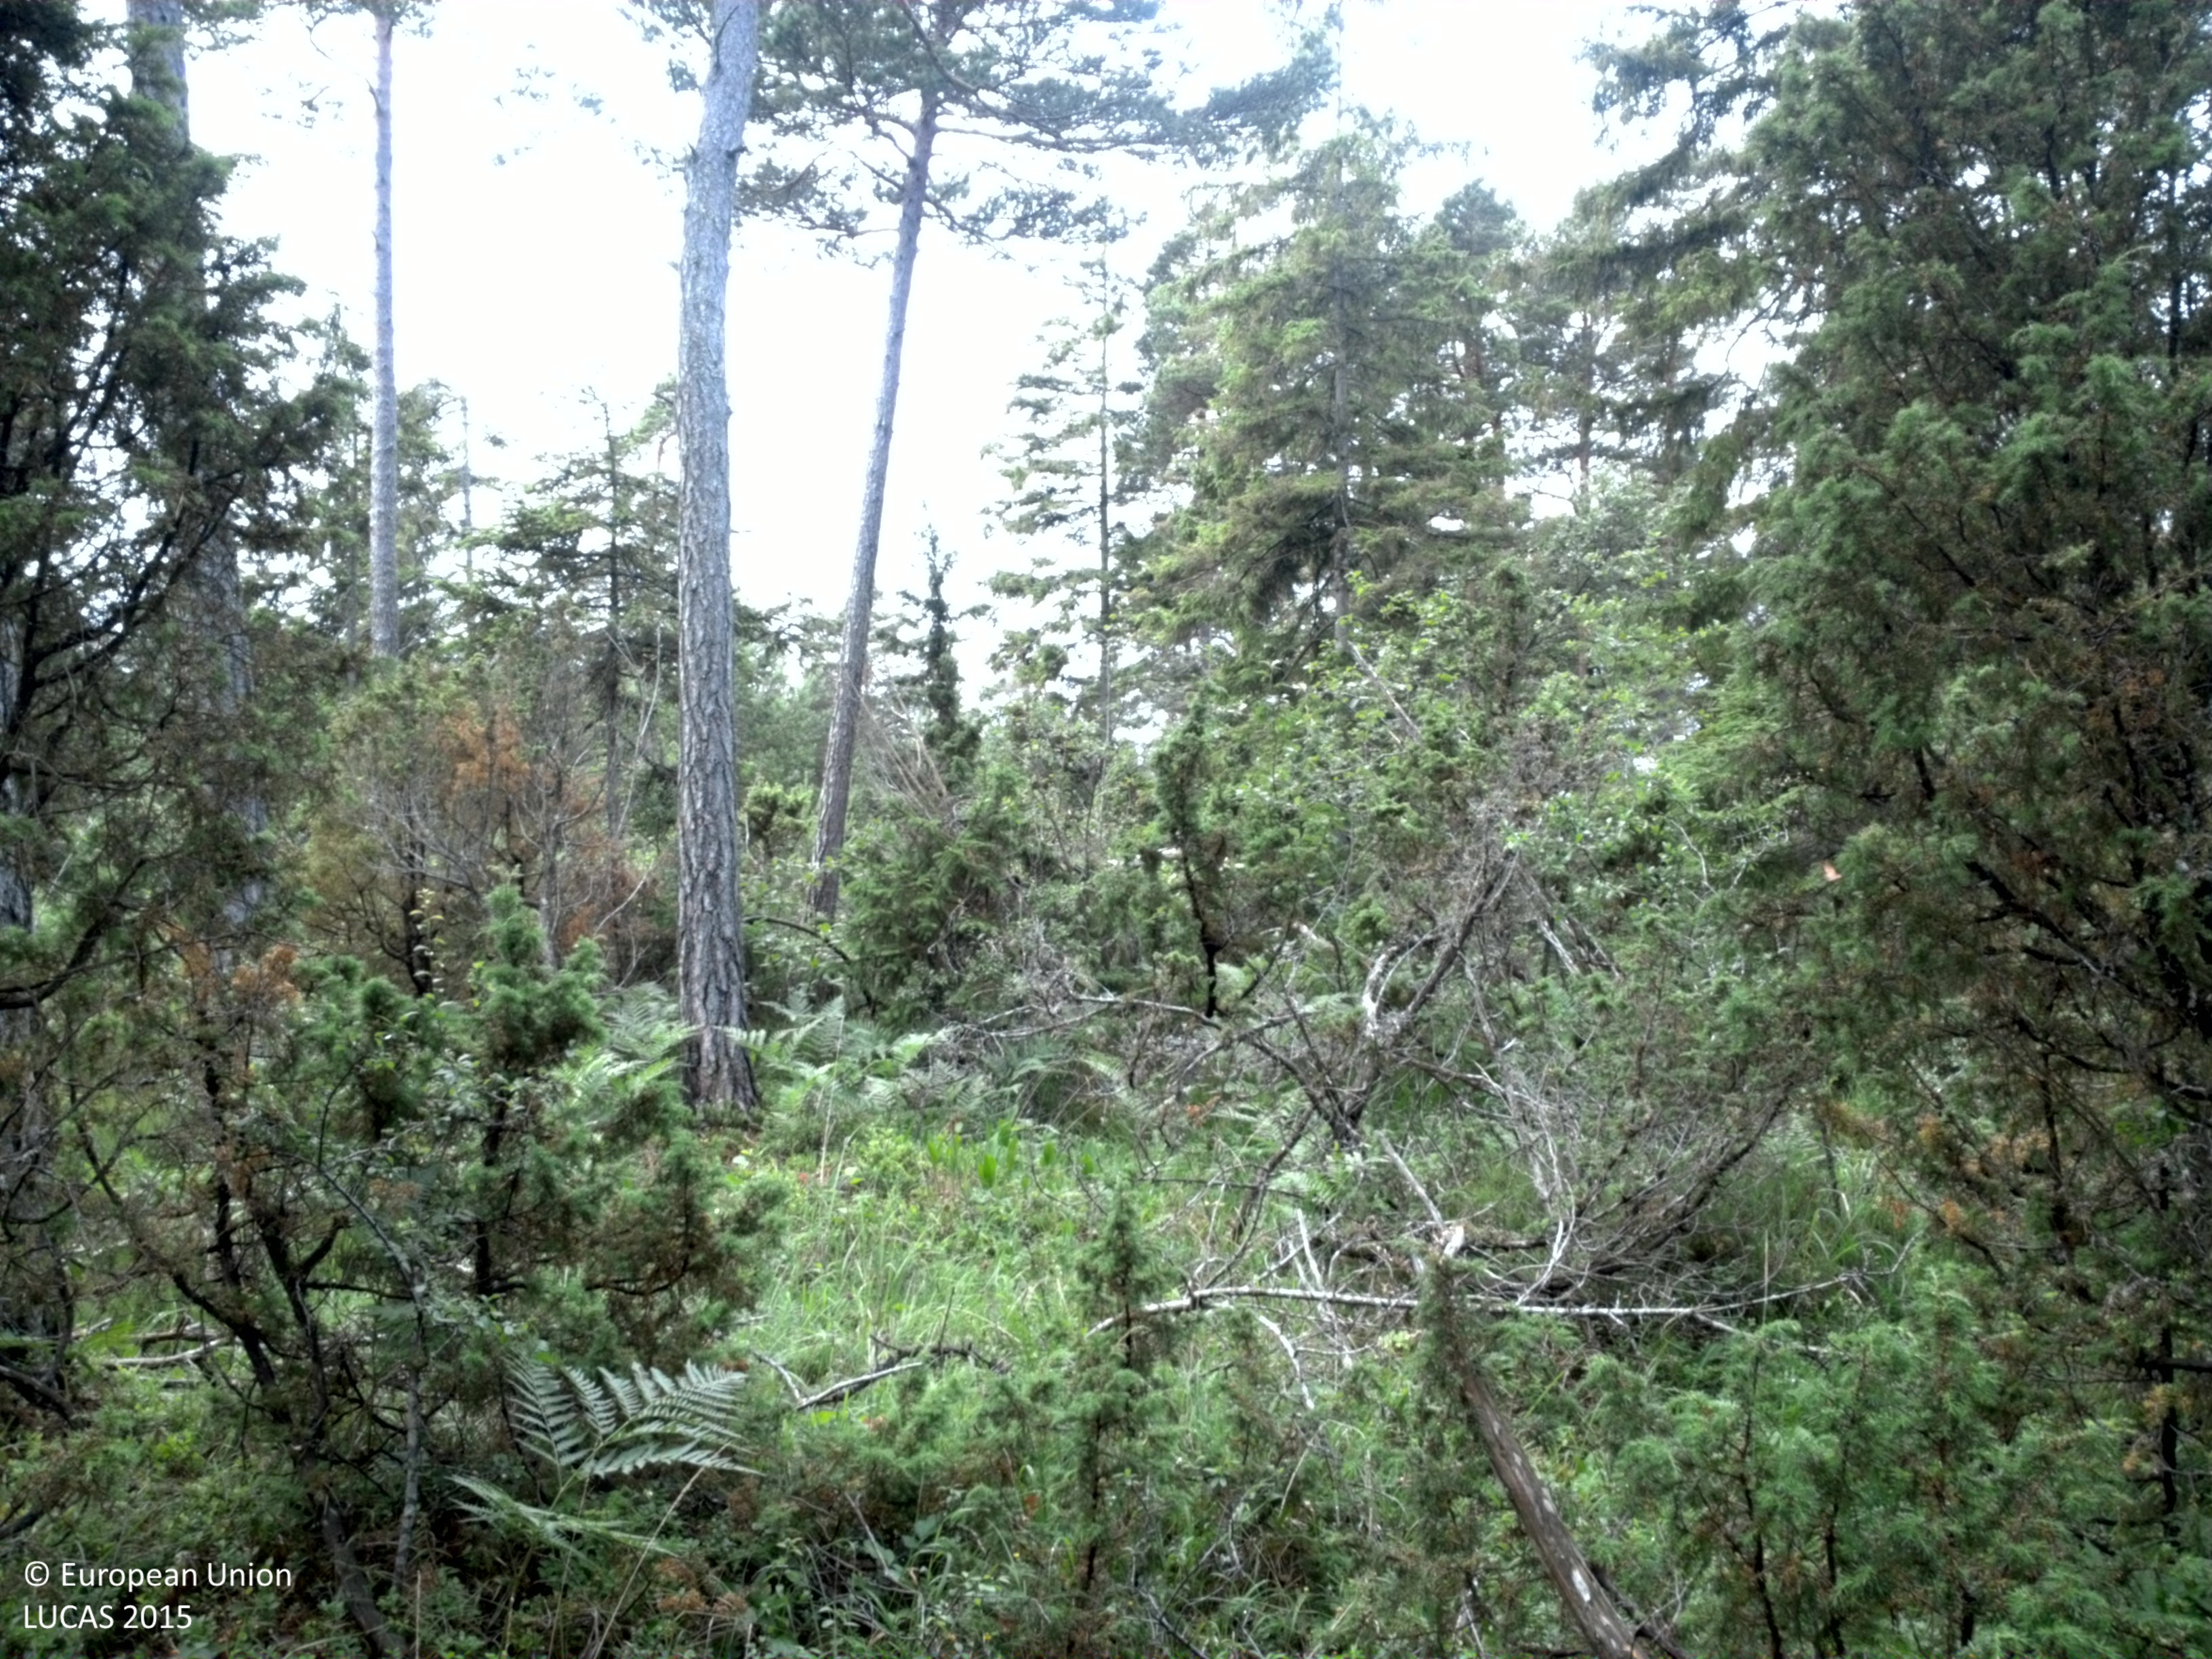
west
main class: Woodland
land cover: Other mixed woodland
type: hemiboreal forest and nemoral coniferous forest and mixed broadleaved-coniferous forest
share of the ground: 50 - 75 %
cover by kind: coniferous forest trees 50 %, broadleaved forest trees 20 %, shrubs 15 %, herbaceous plants 15 %
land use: Forestry
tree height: > 5 m
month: July
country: SE
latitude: 57.4088
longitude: 18.7497
